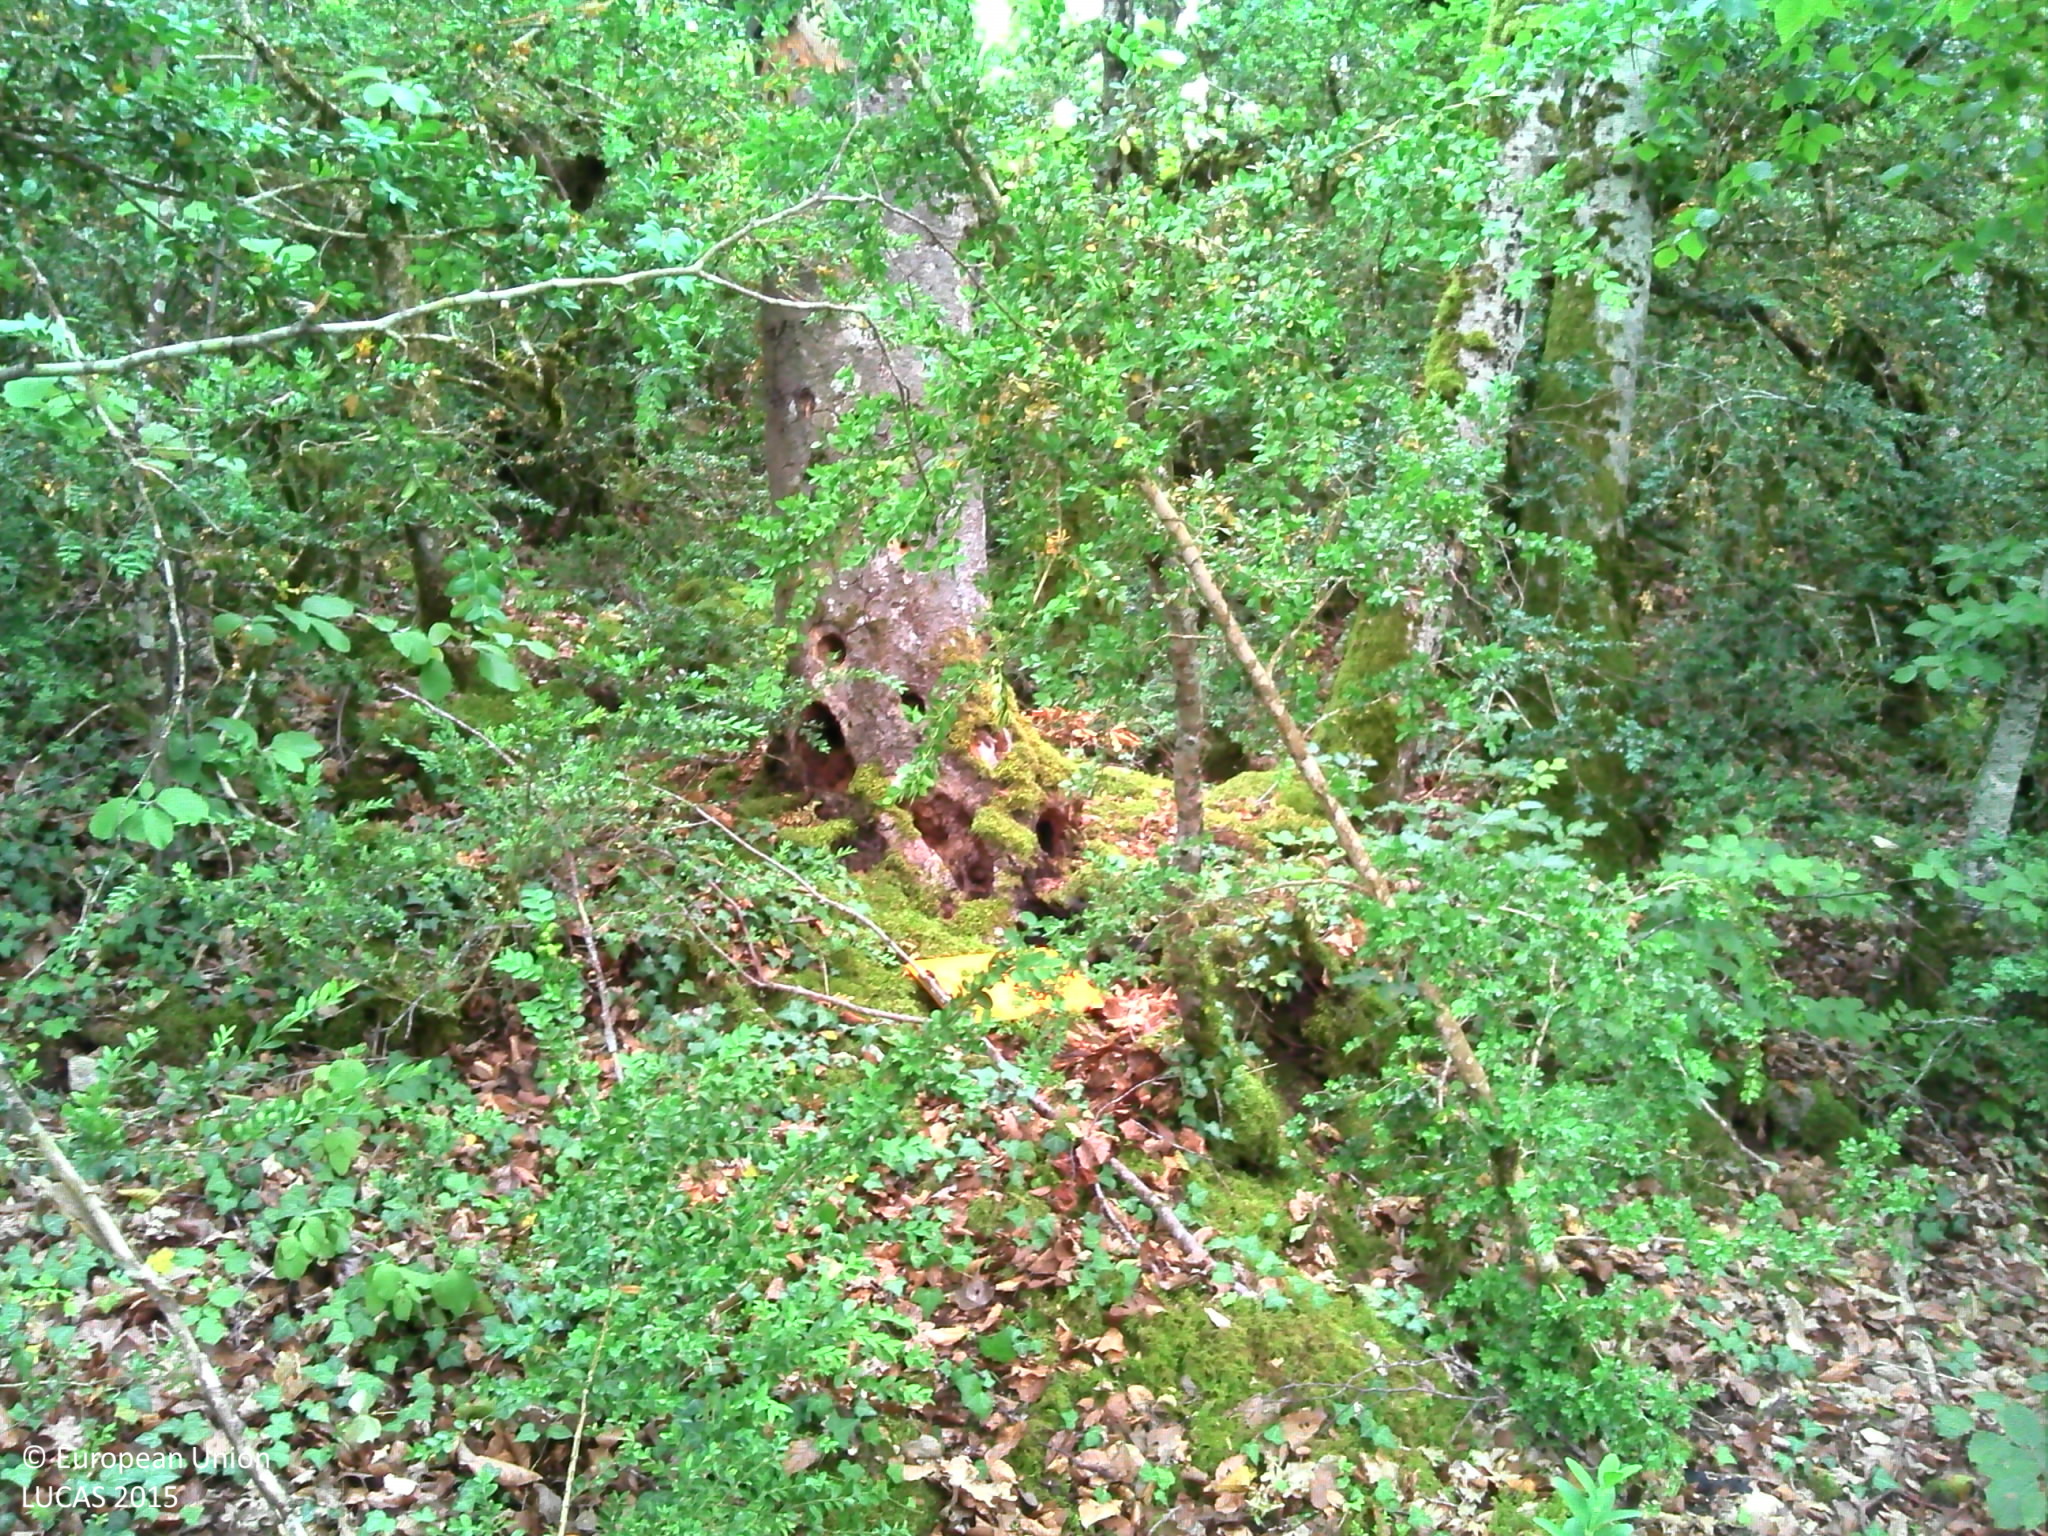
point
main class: Woodland
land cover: Broadleaved woodland
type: acidophilous oak and oak-birch forest
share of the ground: > 75 %
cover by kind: broadleaved forest trees 80 %, shrubs 10 %, herbaceous plants 5 %, lichens and mosses 5 %
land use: Forestry
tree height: > 5 m
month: July
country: FR
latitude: 44.4189
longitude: 2.9583
